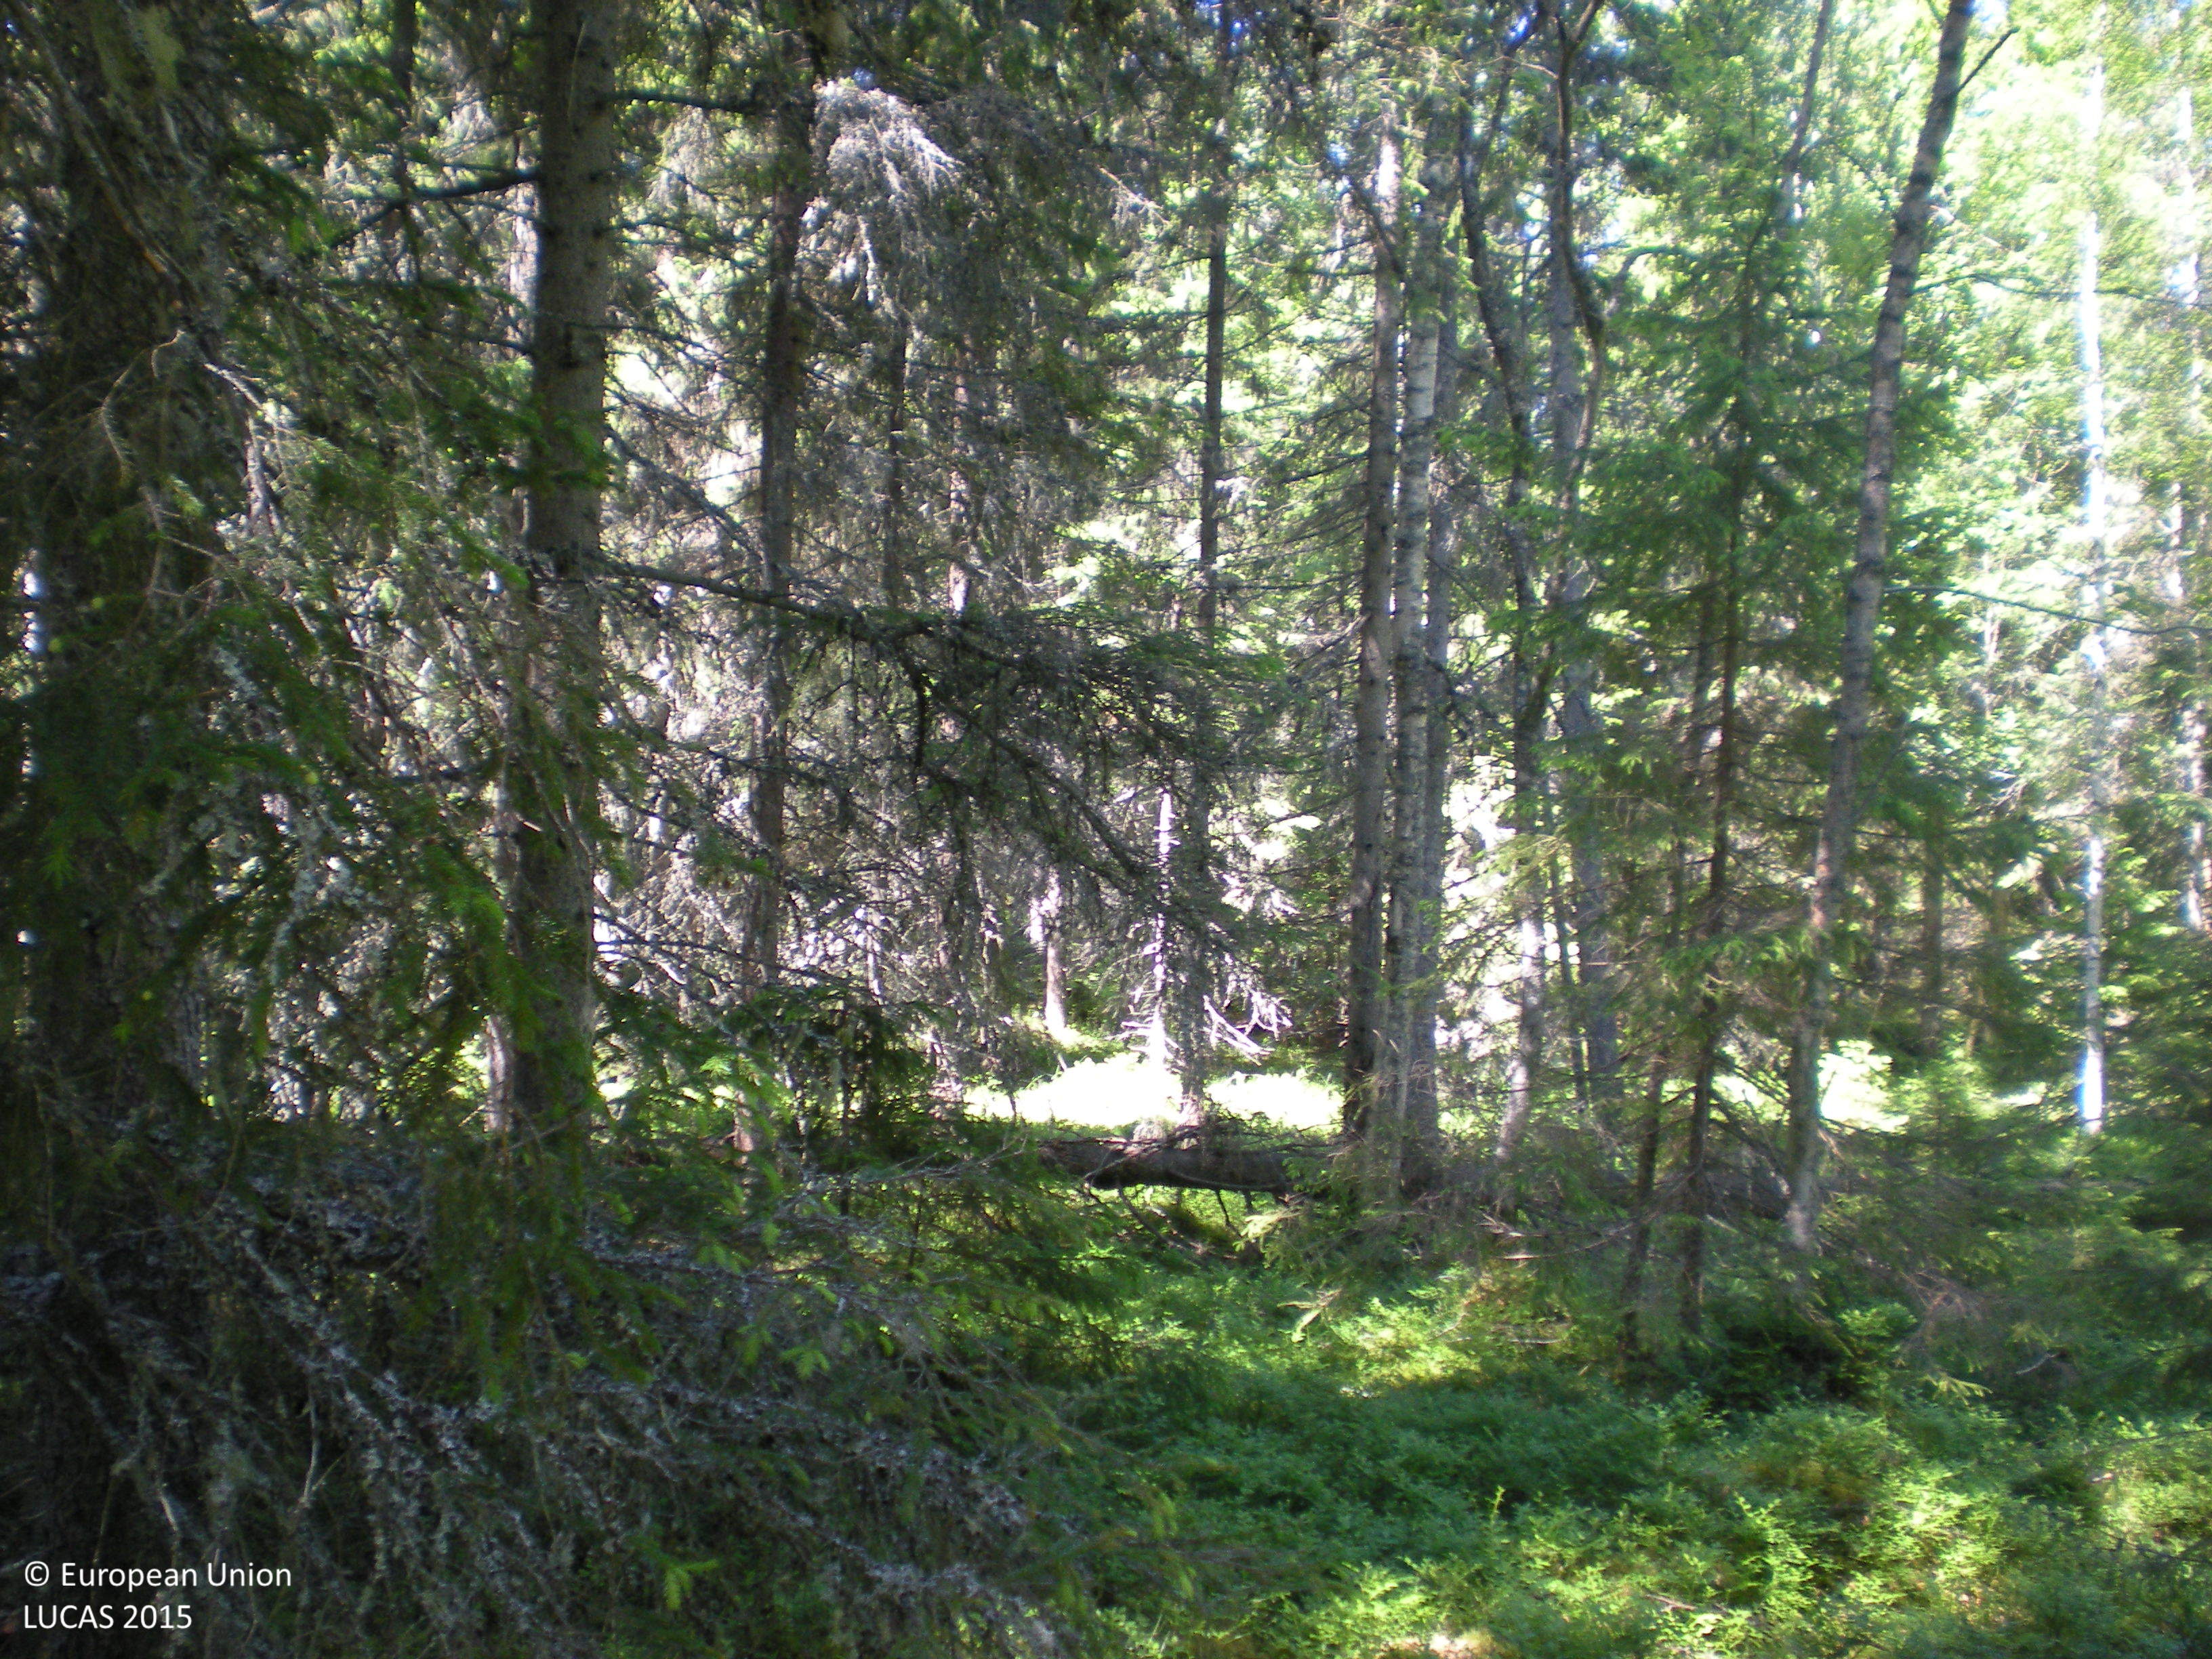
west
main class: Woodland
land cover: Spruce dominated coniferous woodland
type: boreal forest
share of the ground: > 75 %
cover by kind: coniferous forest trees 75 %, shrubs 10 %, lichens and mosses 10 %, broadleaved forest trees 5 %
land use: Amenities, museums, leisure
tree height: > 5 m
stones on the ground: > 50 %
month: June
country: SE
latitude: 60.4934
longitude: 18.0564
